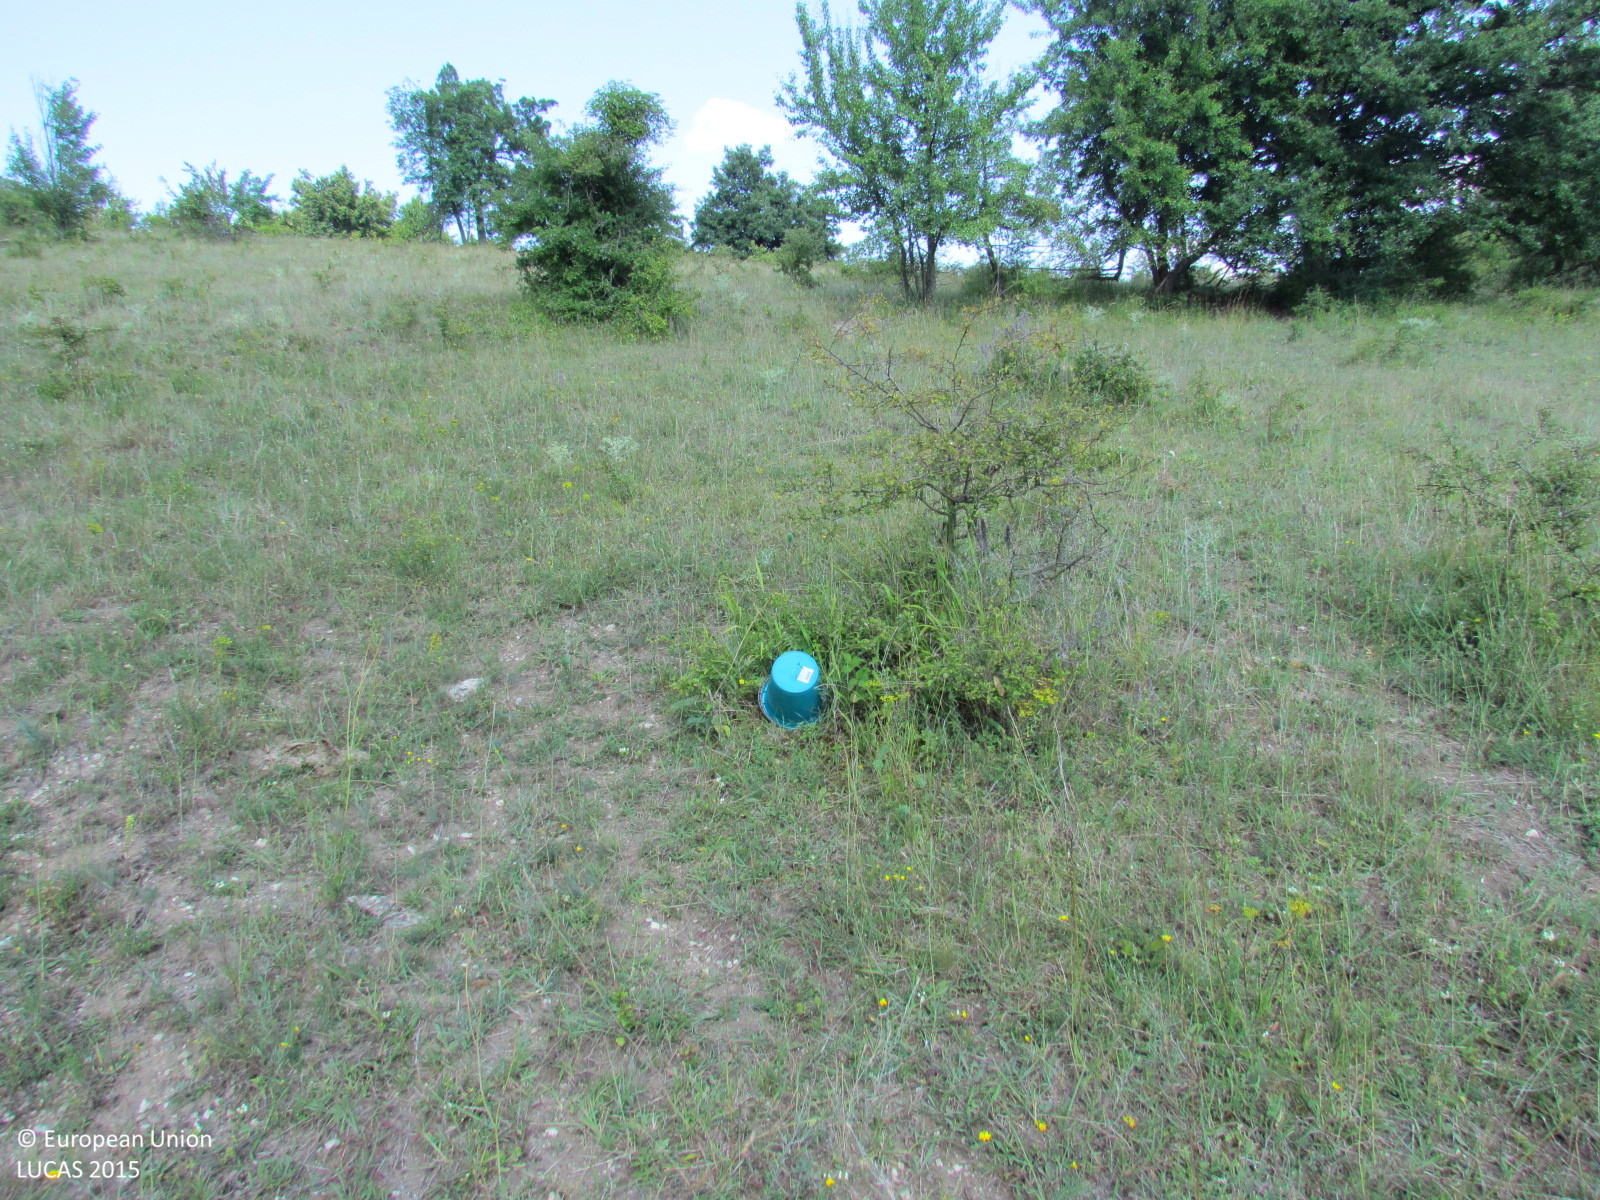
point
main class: Grassland
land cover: Grassland with sparse tree/shrub cover
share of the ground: > 75 %
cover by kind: herbaceous plants 90 %, broadleaved forest trees 5 %, shrubs 5 %
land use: Agriculture (excluding fallow land and kitchen gardens)
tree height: > 5 m
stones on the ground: < 10 %
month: July
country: BG
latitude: 42.8990
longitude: 27.4258
